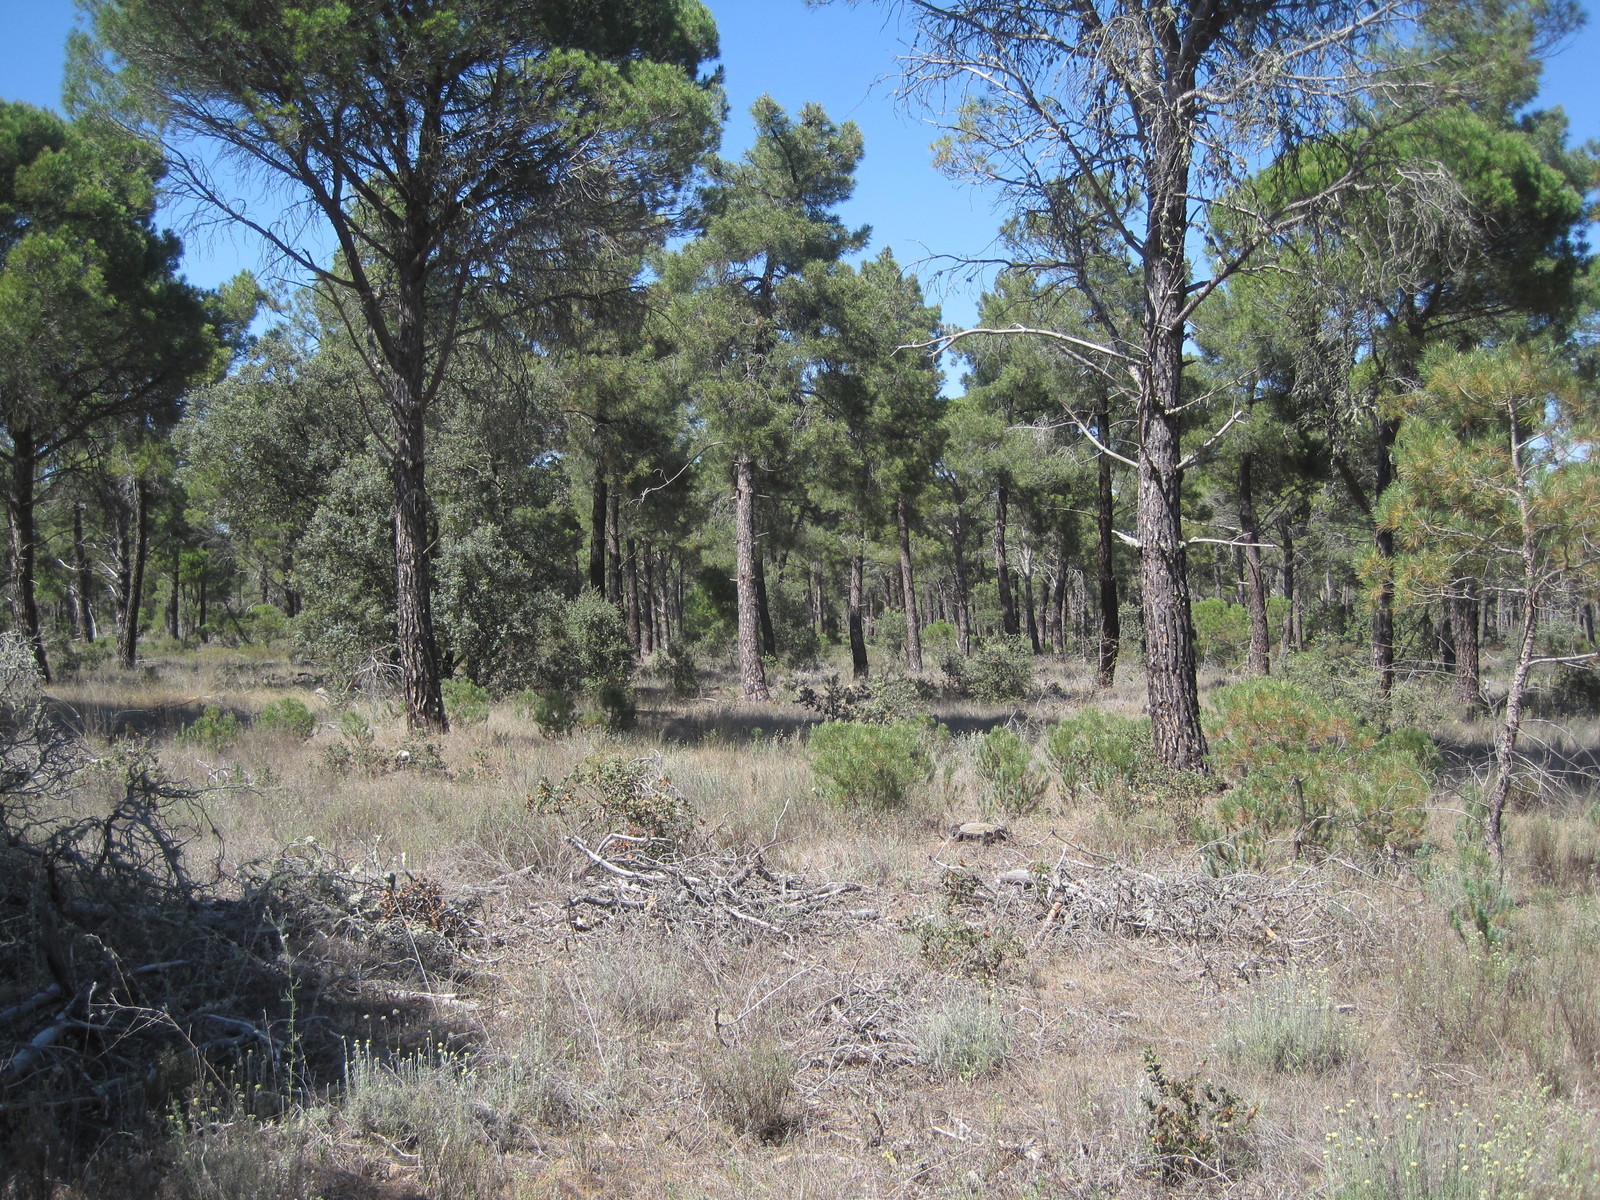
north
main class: Woodland
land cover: Pine dominated coniferous woodland
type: hemiboreal forest and nemoral coniferous forest and mixed broadleaved-coniferous forest
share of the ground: 50 - 75 %
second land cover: Grassland without tree/shrub cover
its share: > 75 %
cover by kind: coniferous forest trees 65 %, herbaceous plants 25 %, shrubs 10 %
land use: Forestry
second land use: Agriculture (excluding fallow land and kitchen gardens)
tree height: > 5 m
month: June
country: ES
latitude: 41.7802
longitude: -5.3993
